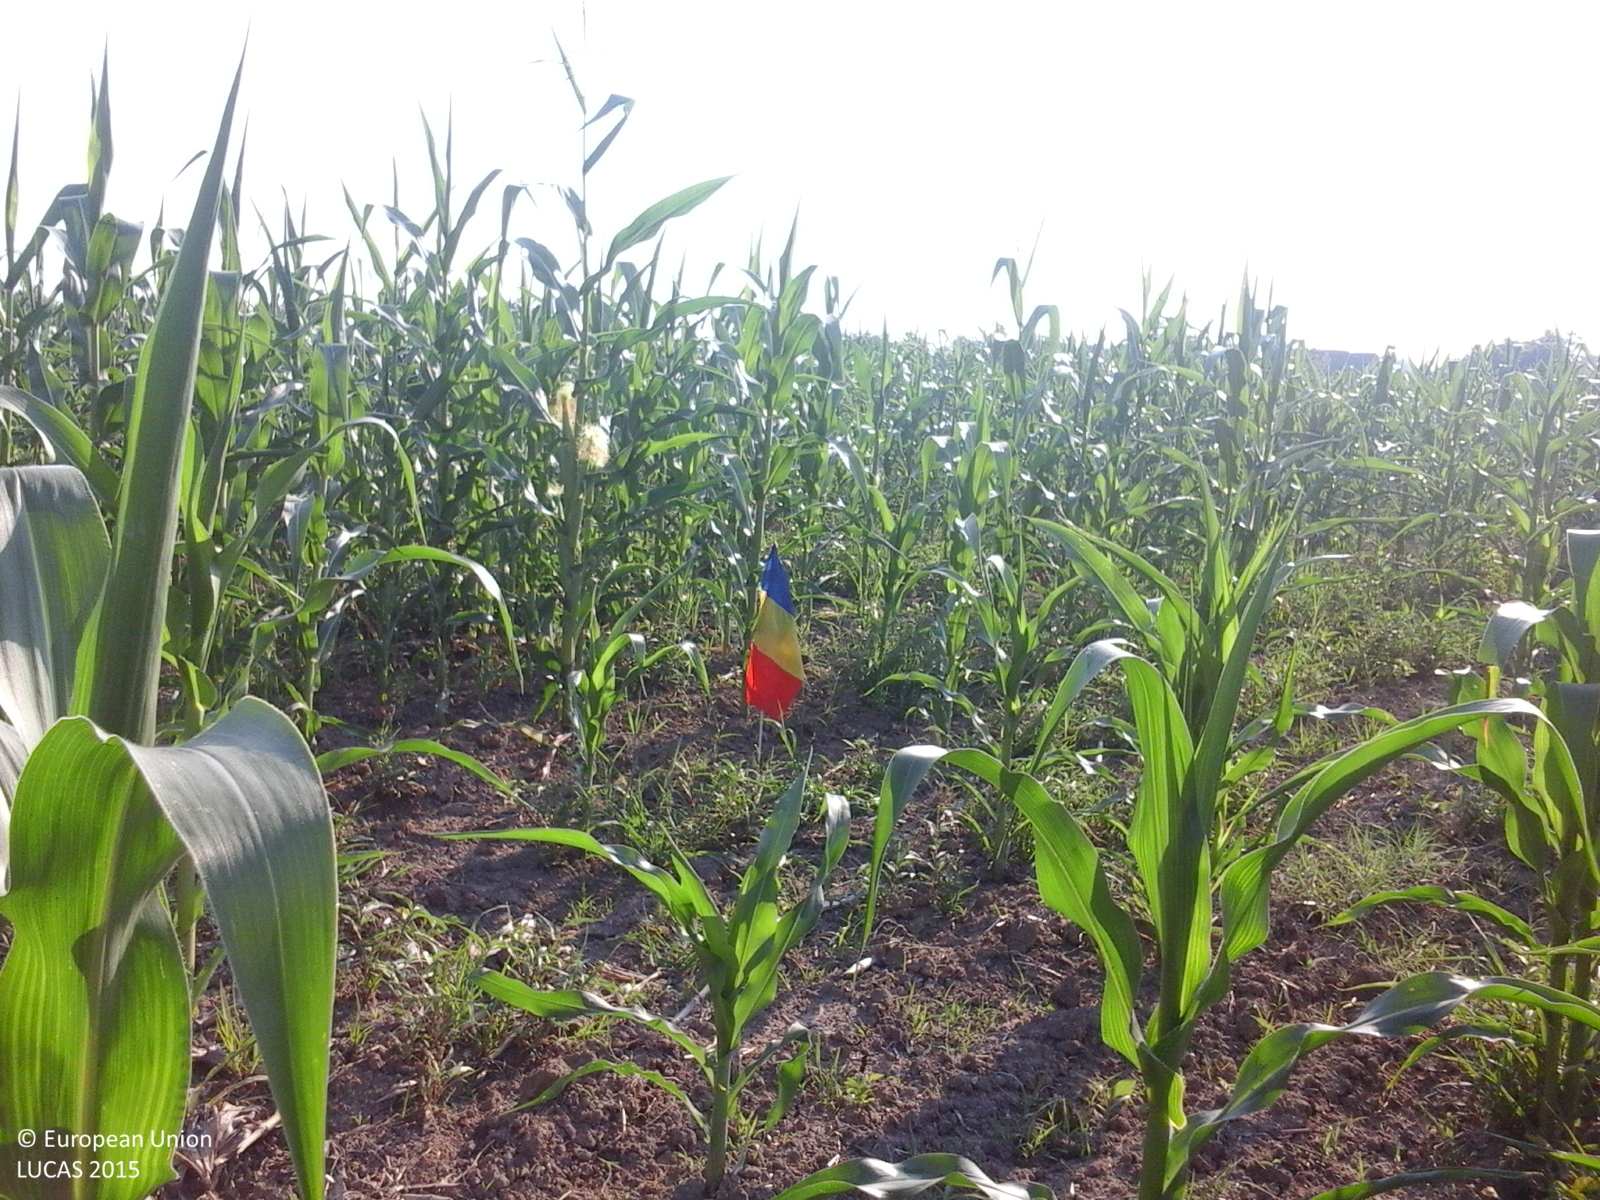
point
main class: Cropland
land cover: Maize
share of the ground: > 75 %
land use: Agriculture (excluding fallow land and kitchen gardens)
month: July
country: RO
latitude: 44.6070
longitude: 24.7561
